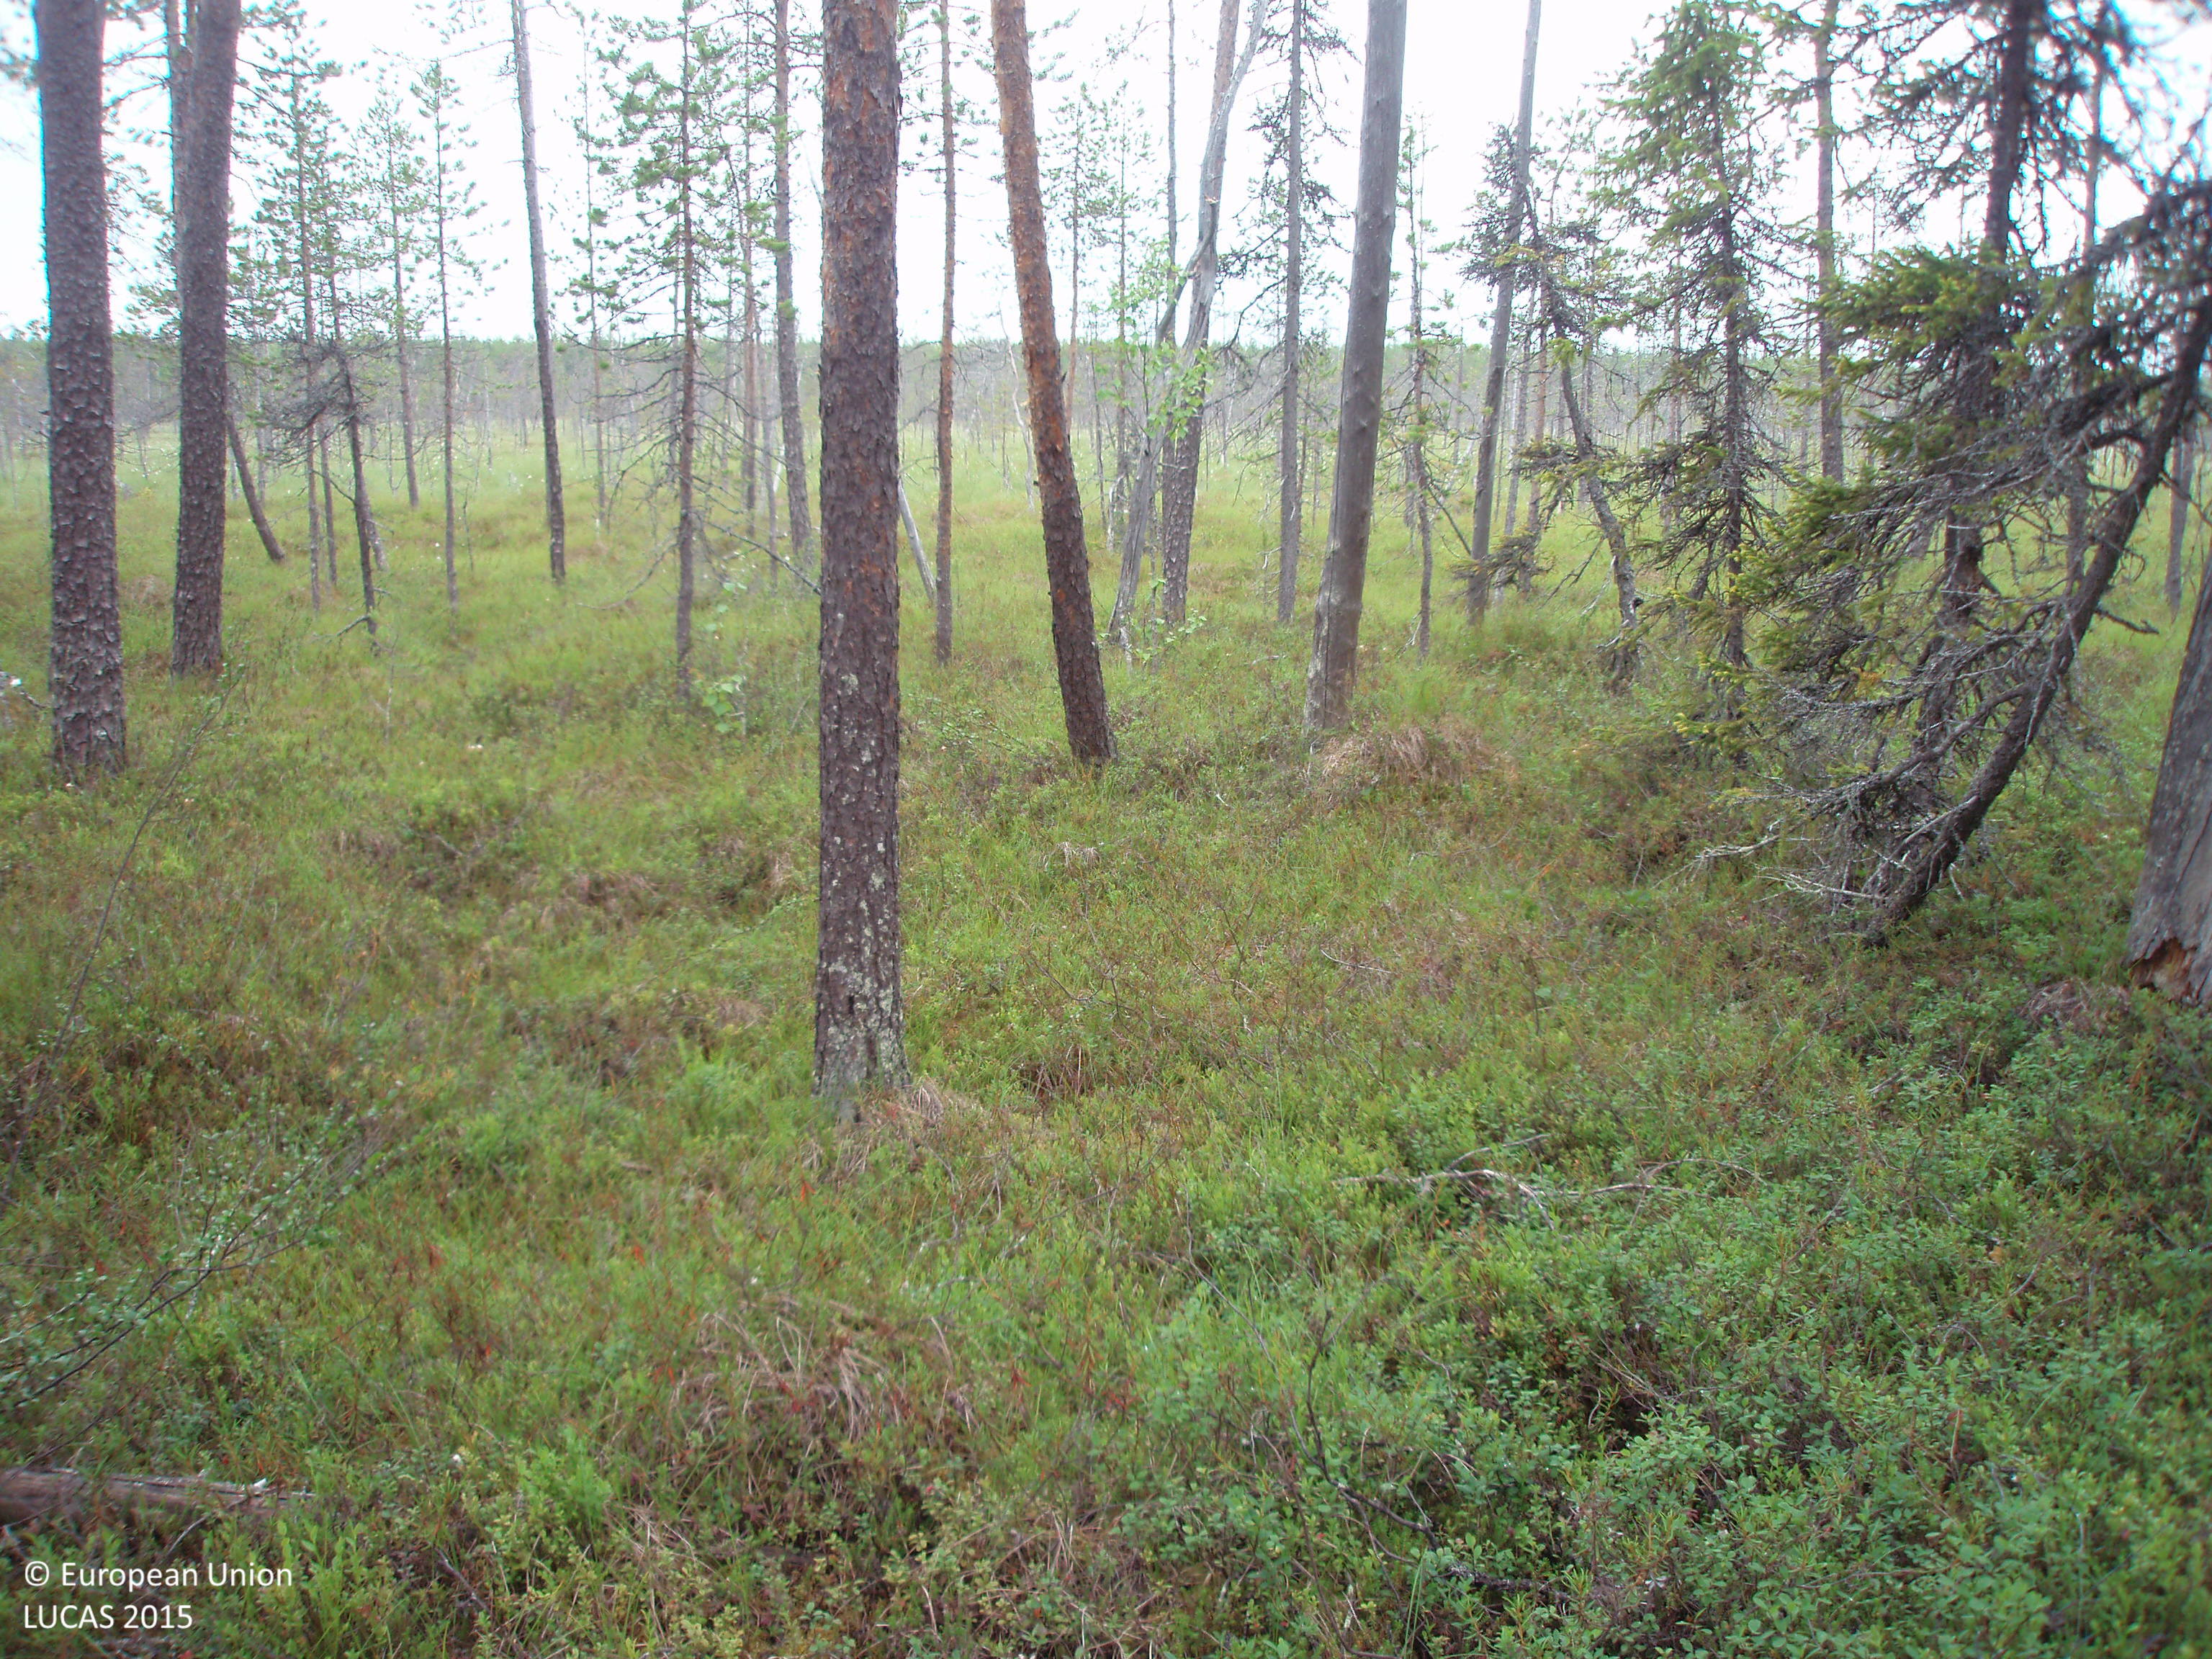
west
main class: Woodland
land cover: Pine dominated mixed woodland
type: boreal forest
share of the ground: 50 - 75 %
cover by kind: shrubs 40 %, coniferous forest trees 35 %, broadleaved forest trees 15 %, herbaceous plants 5 %, lichens and mosses 5 %
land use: Forestry
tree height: > 5 m
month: July
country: FI
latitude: 67.1871
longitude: 27.7926
